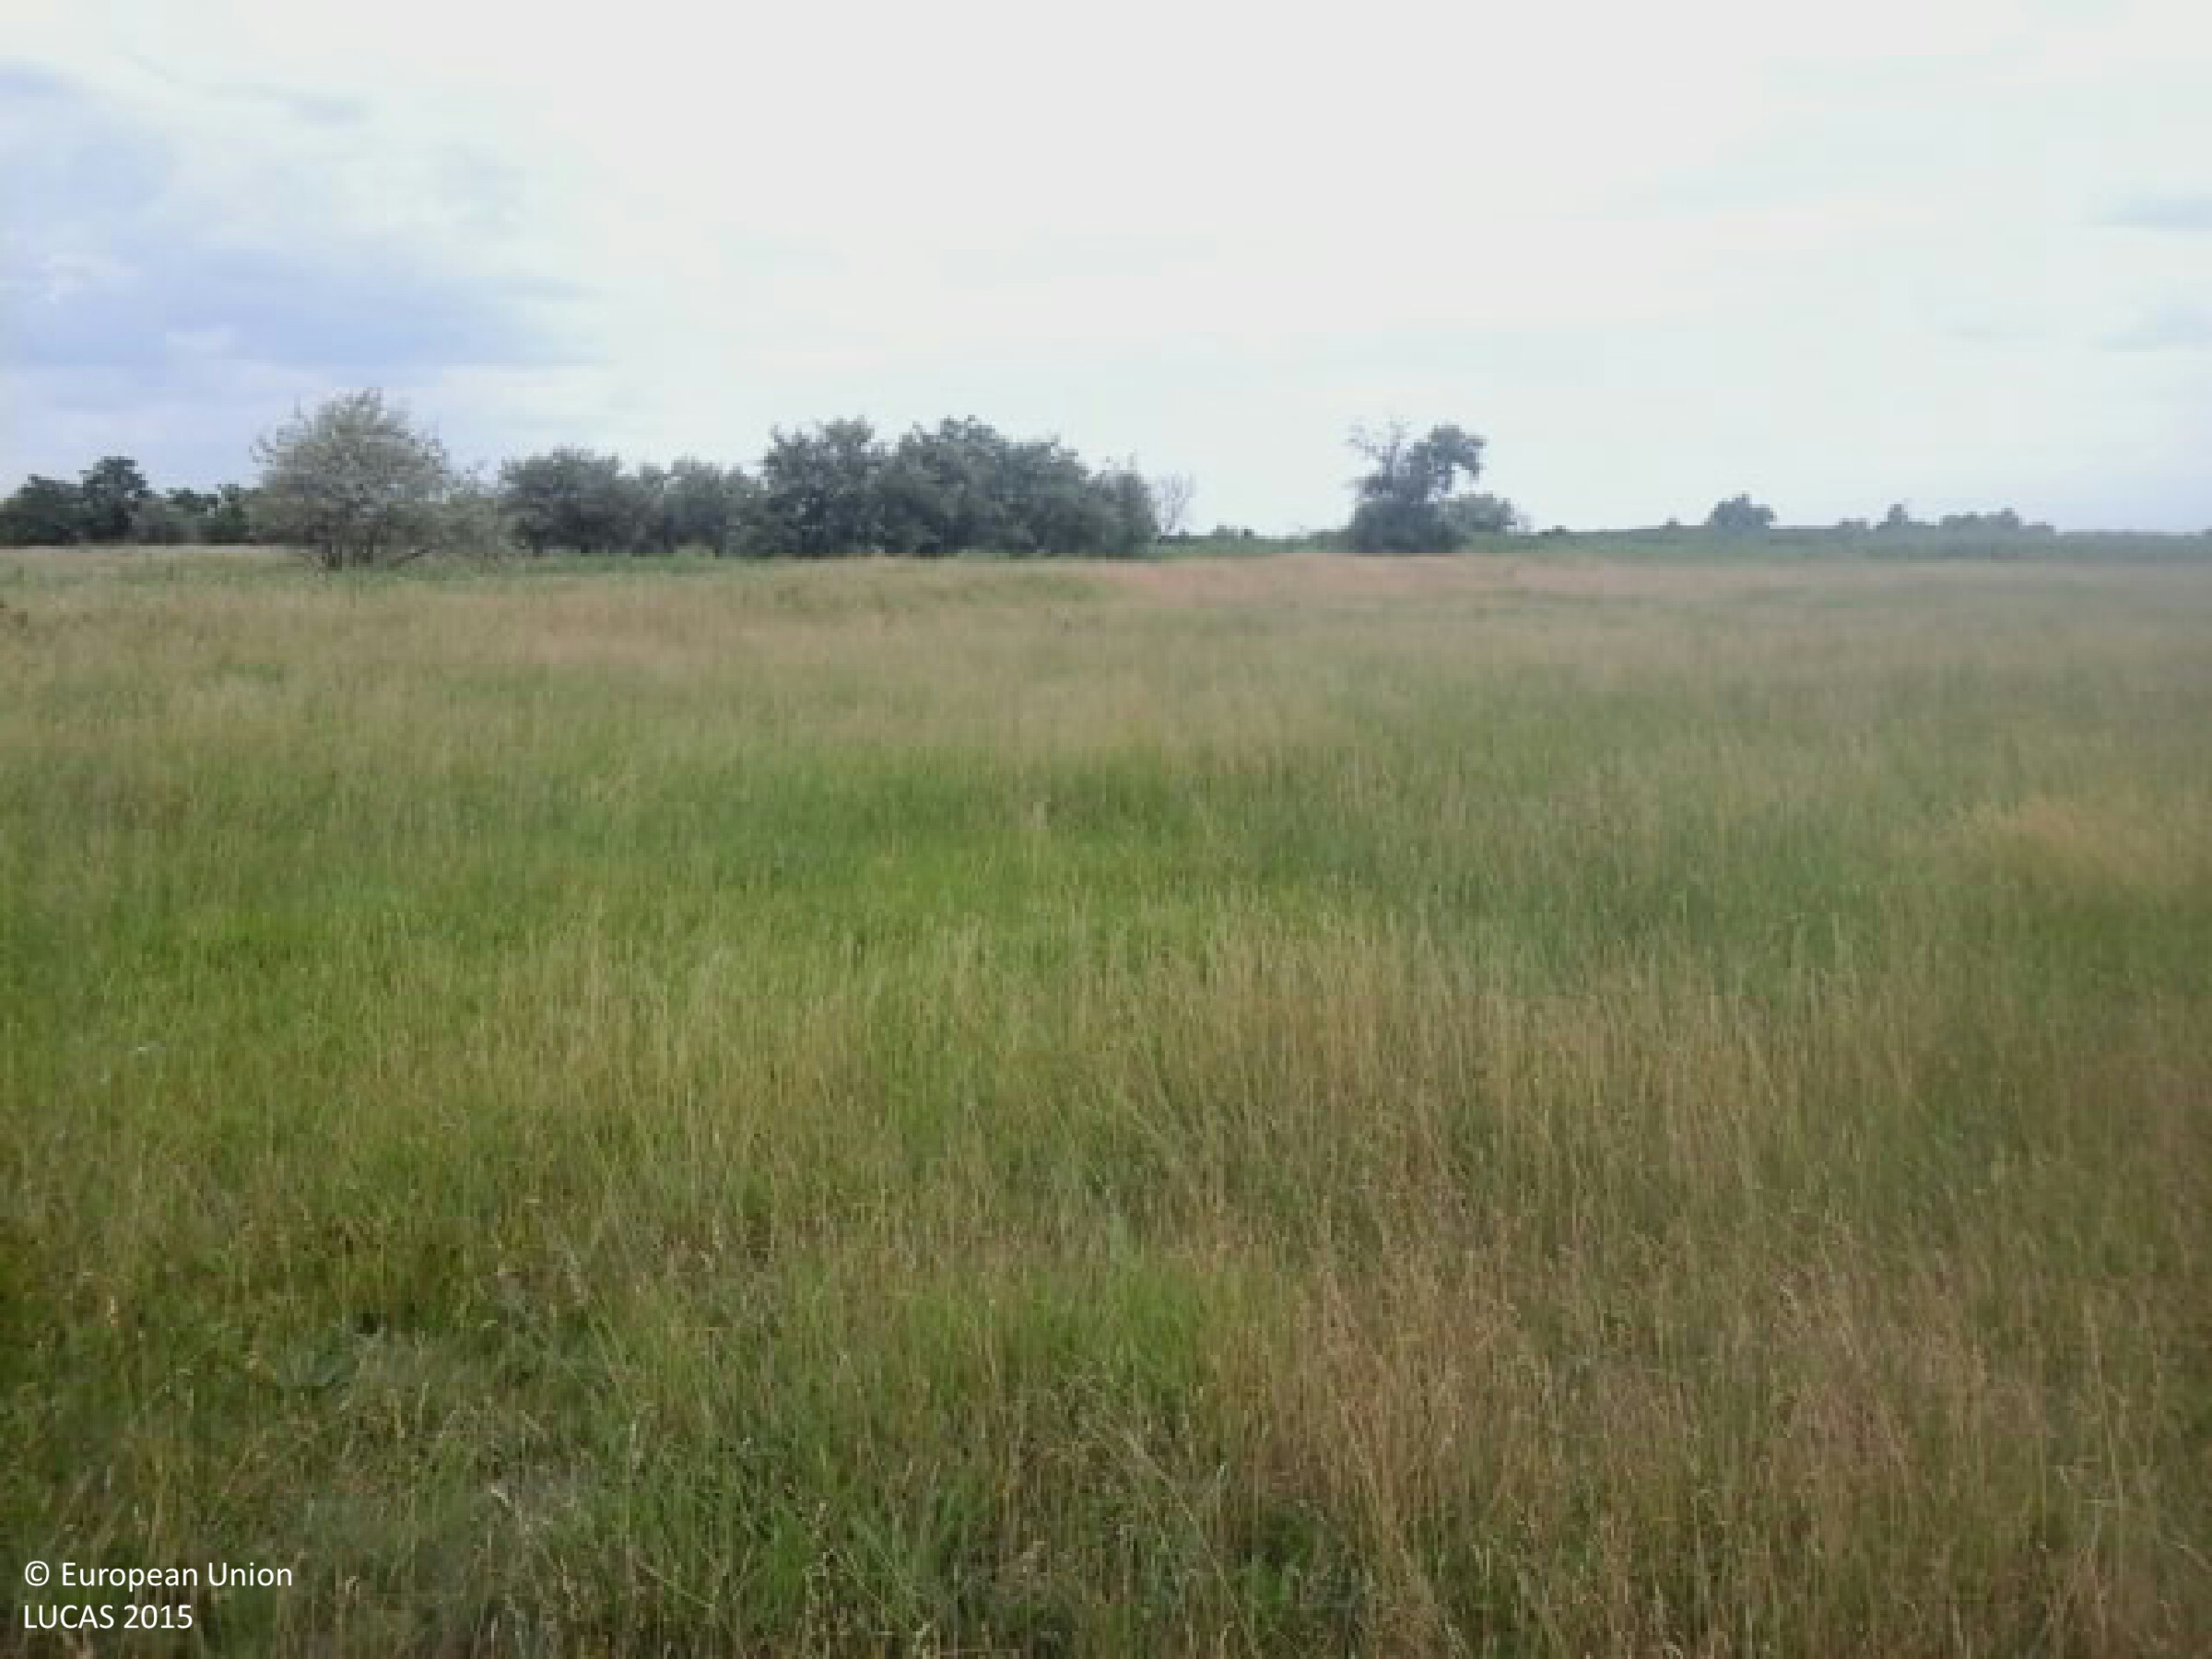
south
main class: Grassland
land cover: Grassland without tree/shrub cover
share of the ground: > 75 %
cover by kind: herbaceous plants 100 %
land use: Agriculture (excluding fallow land and kitchen gardens)
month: June
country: HU
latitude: 46.5410
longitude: 20.3135
